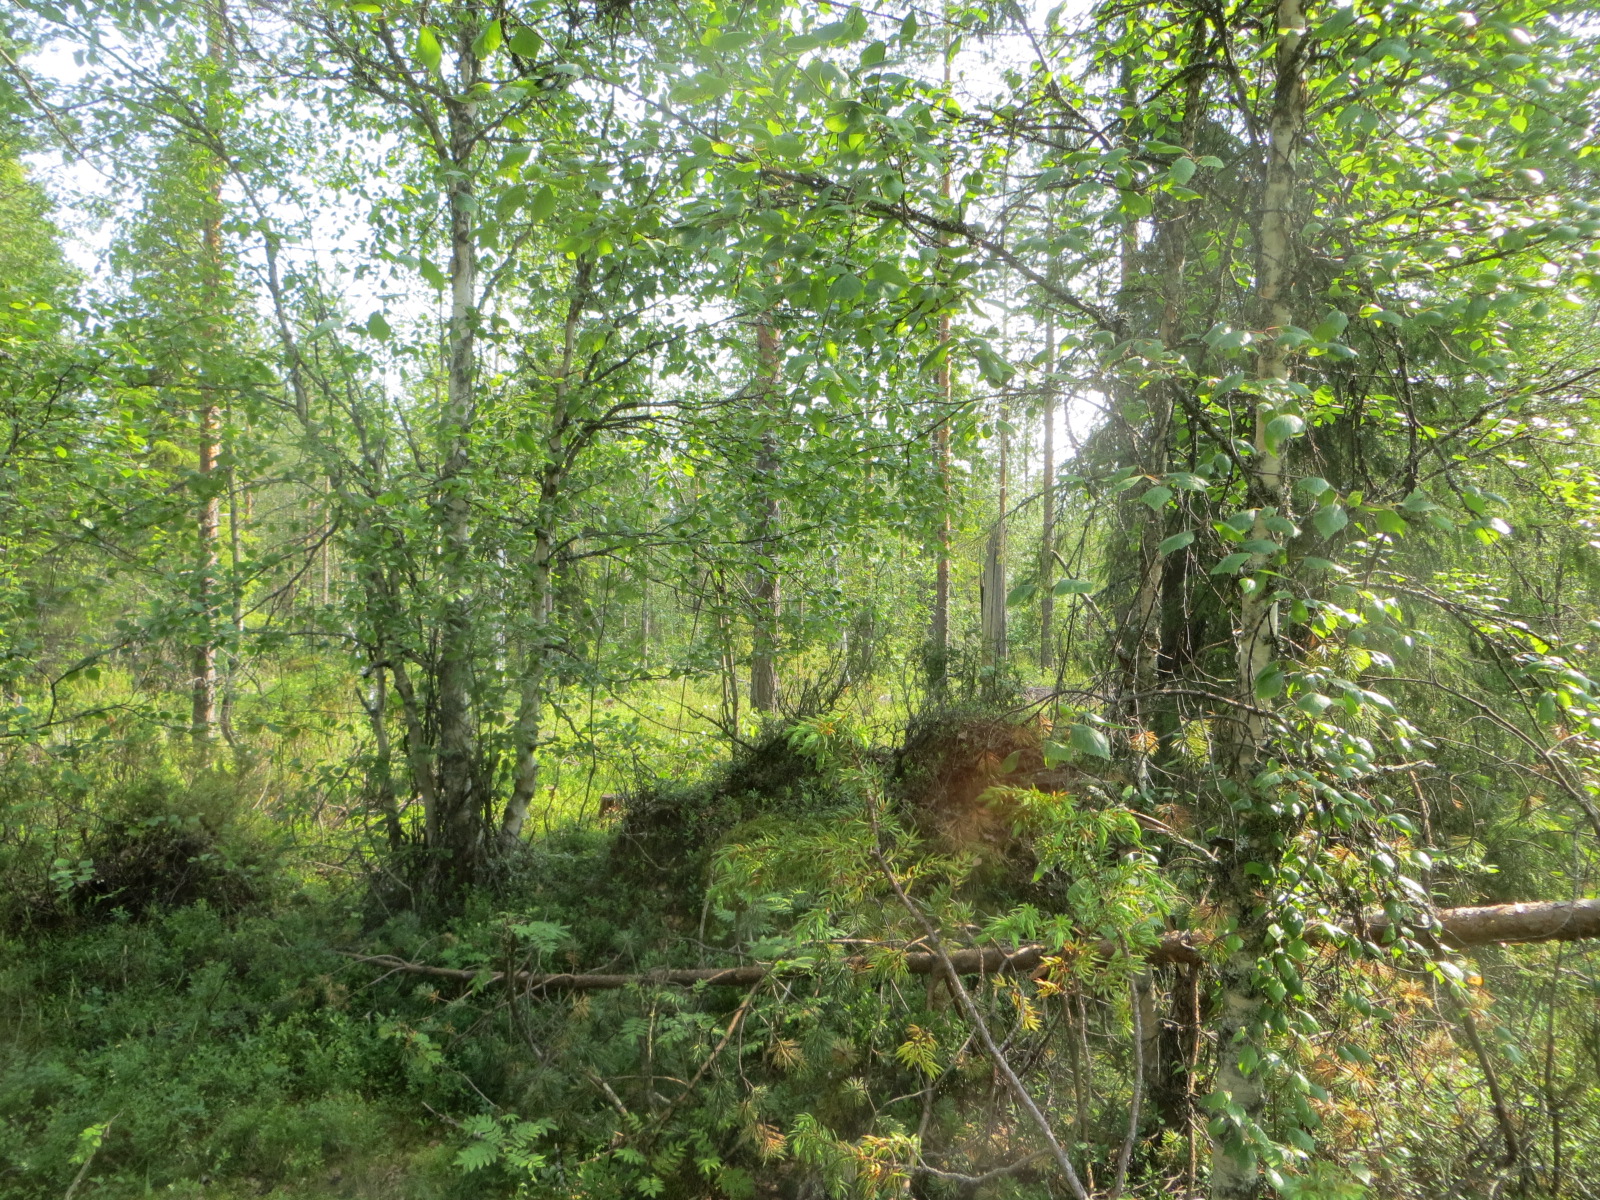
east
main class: Woodland
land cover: Other mixed woodland
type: boreal forest
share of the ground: 50 - 75 %
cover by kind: coniferous forest trees 40 %, broadleaved forest trees 30 %, shrubs 30 %
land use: Forestry
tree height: > 5 m
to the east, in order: Other mixed woodland; Ditches and canals; Abandoned hedges; Paved roads, cycling and walking lanes; Abandoned hedges; Ditches and canals; Other mixed woodland; Ditches and canals; Pine dominated coniferous woodland; Ditches and canals; Pine dominated coniferous woodland; Peatbogs; Pine dominated coniferous woodland; Ditches and canals; Pine dominated coniferous woodland
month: July
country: FI
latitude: 65.8839
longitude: 25.5364
